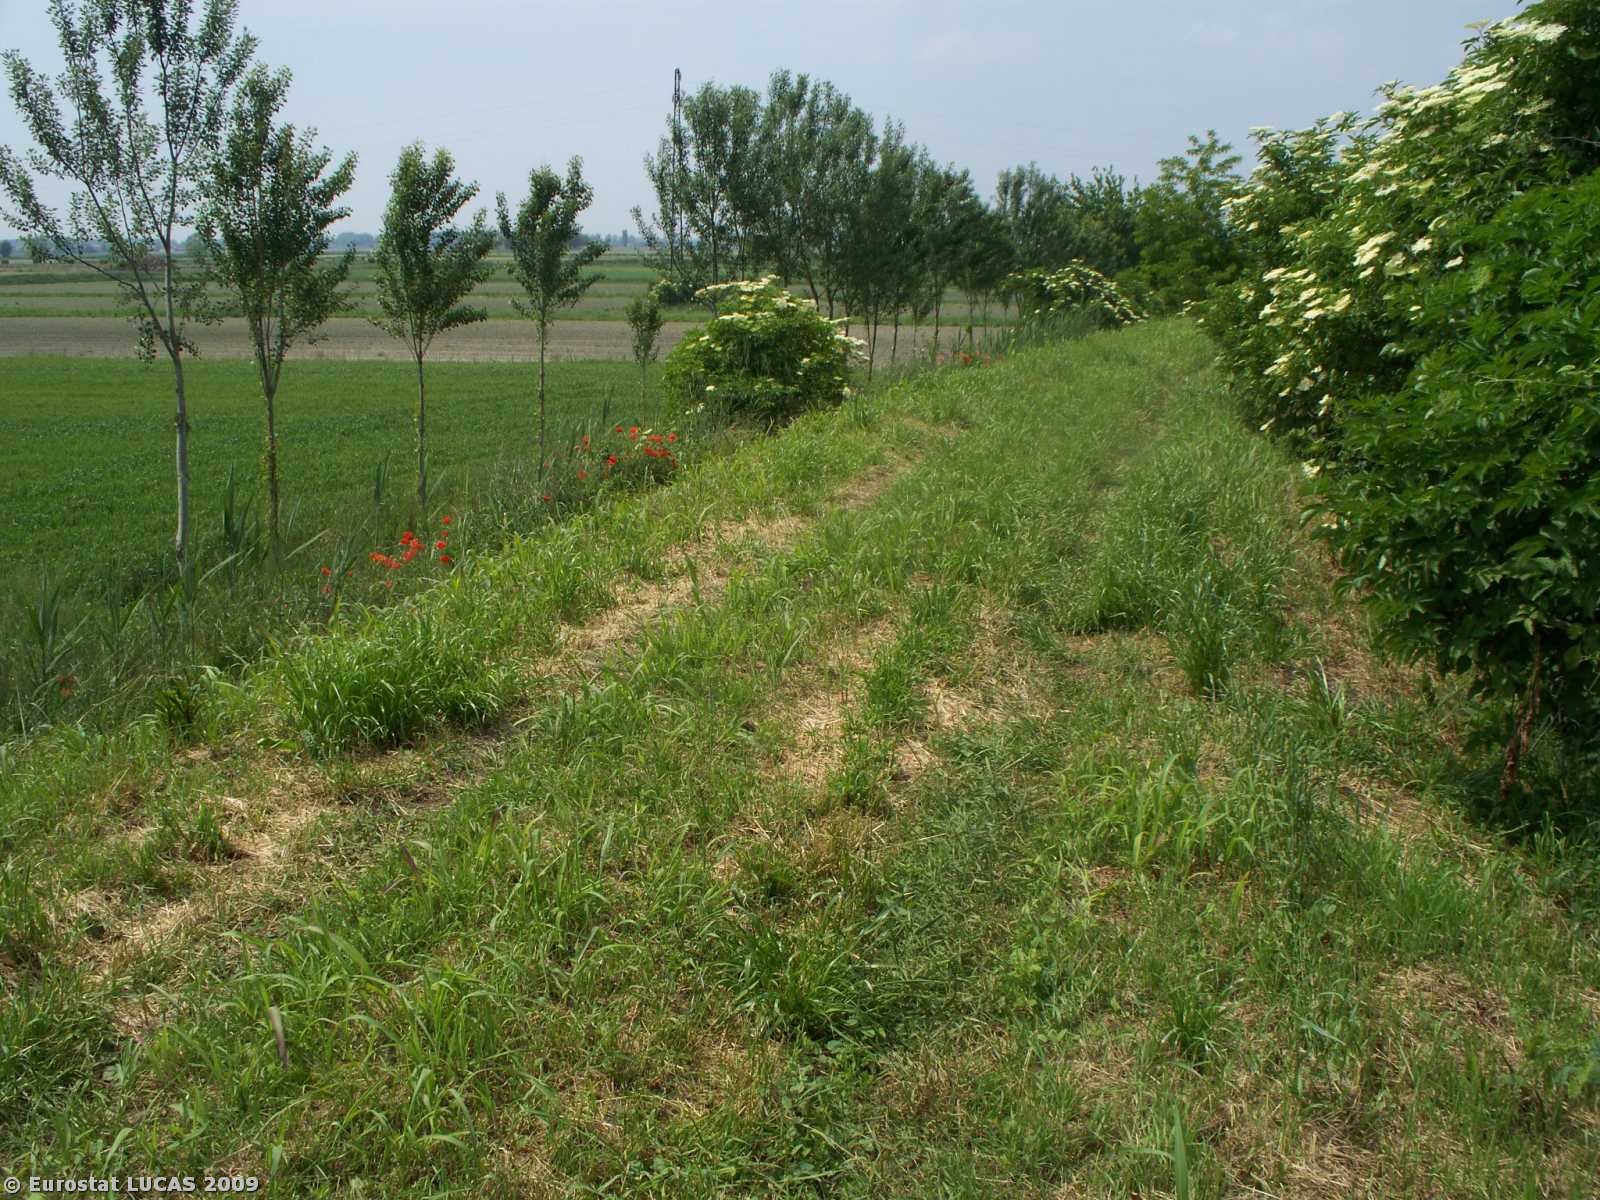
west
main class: Shrubland
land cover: Shrubland with sparse tree cover
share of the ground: > 75 %
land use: Water transport
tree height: < 5 m
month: May
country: IT
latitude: 45.1601
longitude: 12.0446
